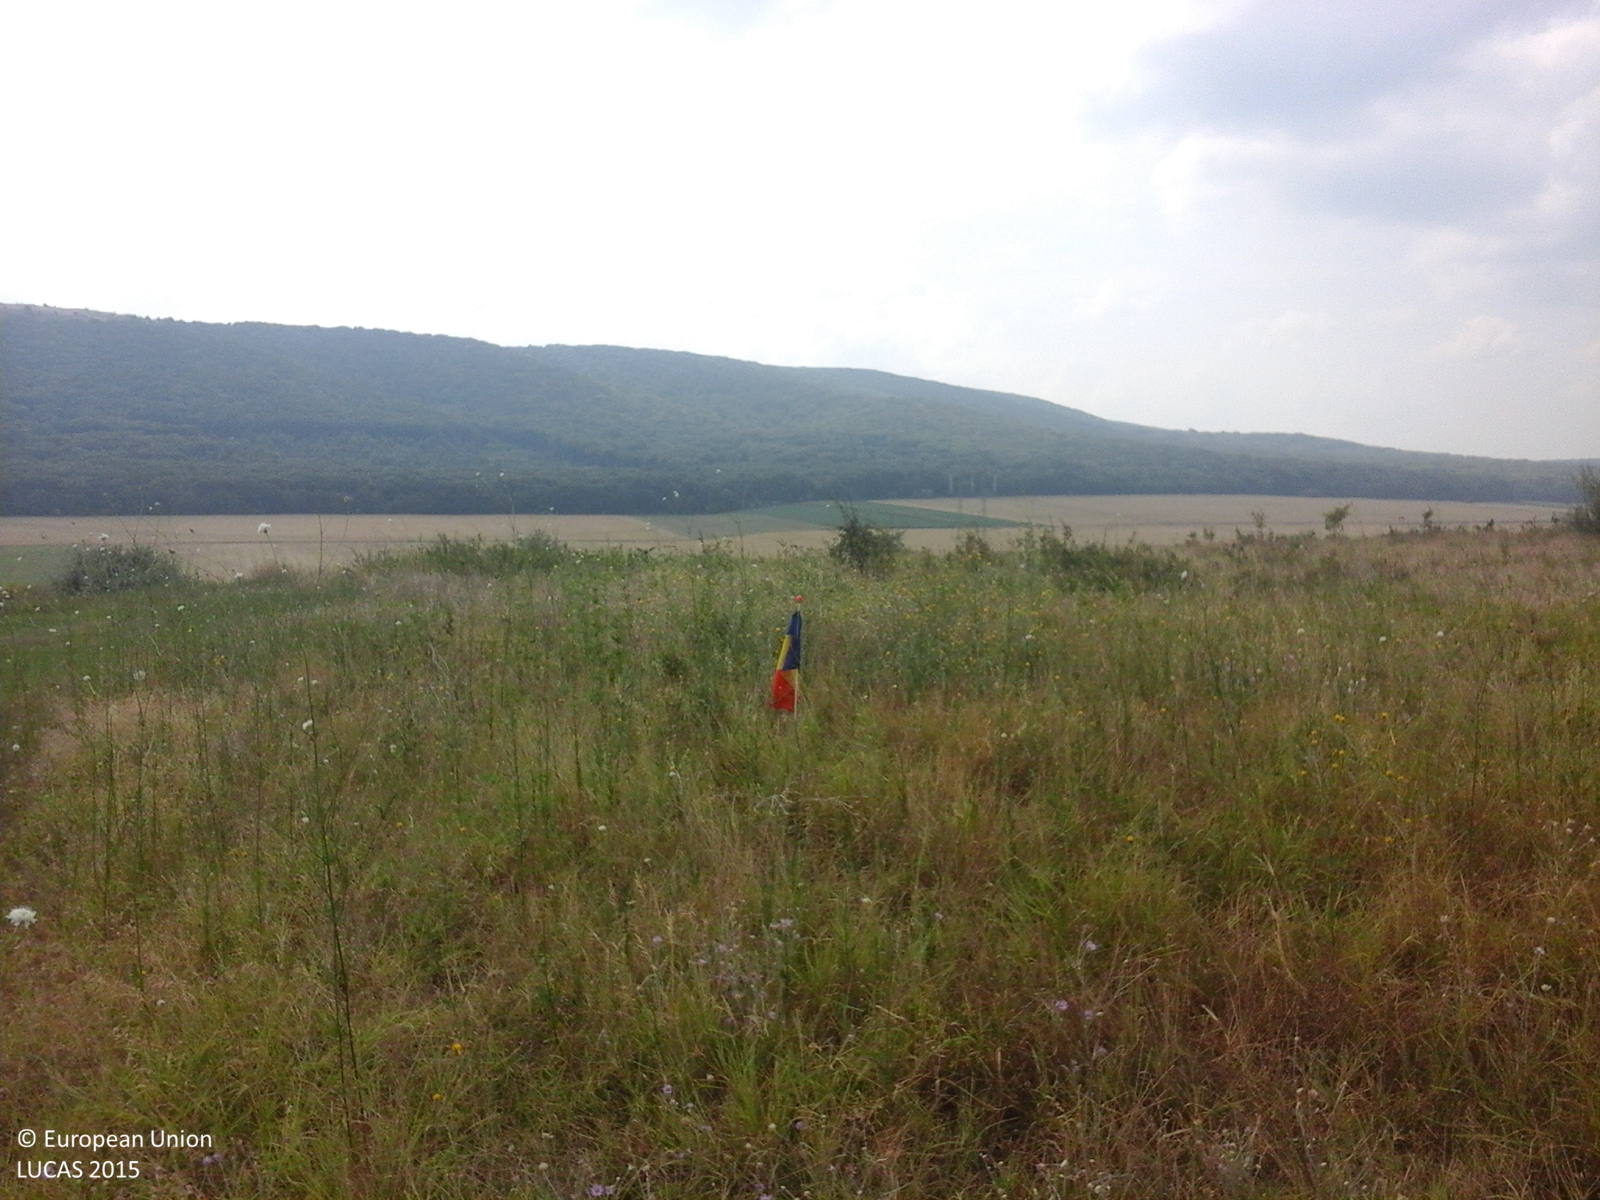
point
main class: Grassland
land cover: Spontaneously vegetated surfaces
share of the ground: > 75 %
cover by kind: herbaceous plants 100 %
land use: Agriculture (excluding fallow land and kitchen gardens)
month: July
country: RO
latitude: 45.1119
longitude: 28.4705
